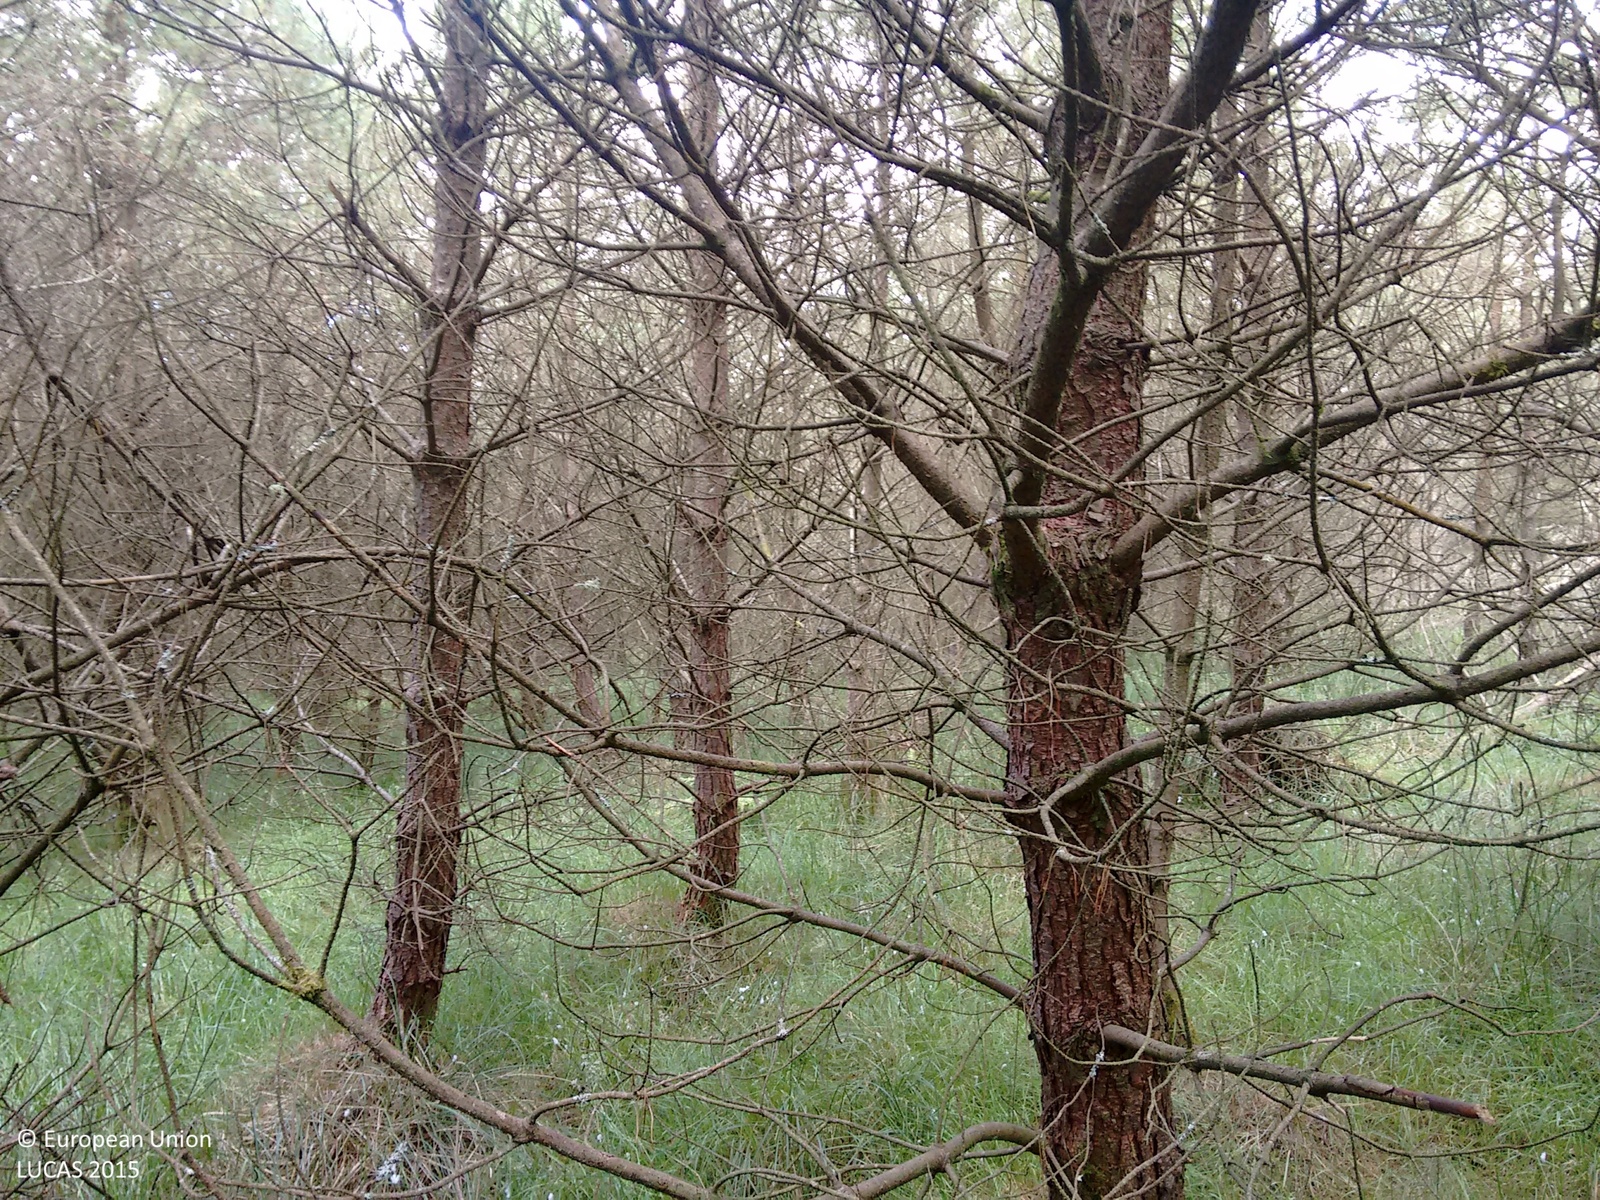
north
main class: Woodland
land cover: Pine dominated coniferous woodland
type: exotic forest
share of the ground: > 75 %
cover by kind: coniferous forest trees 100 %
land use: Forestry
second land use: Amenities, museums, leisure
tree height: > 5 m
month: August
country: GB
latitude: 55.9236
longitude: -3.8634
